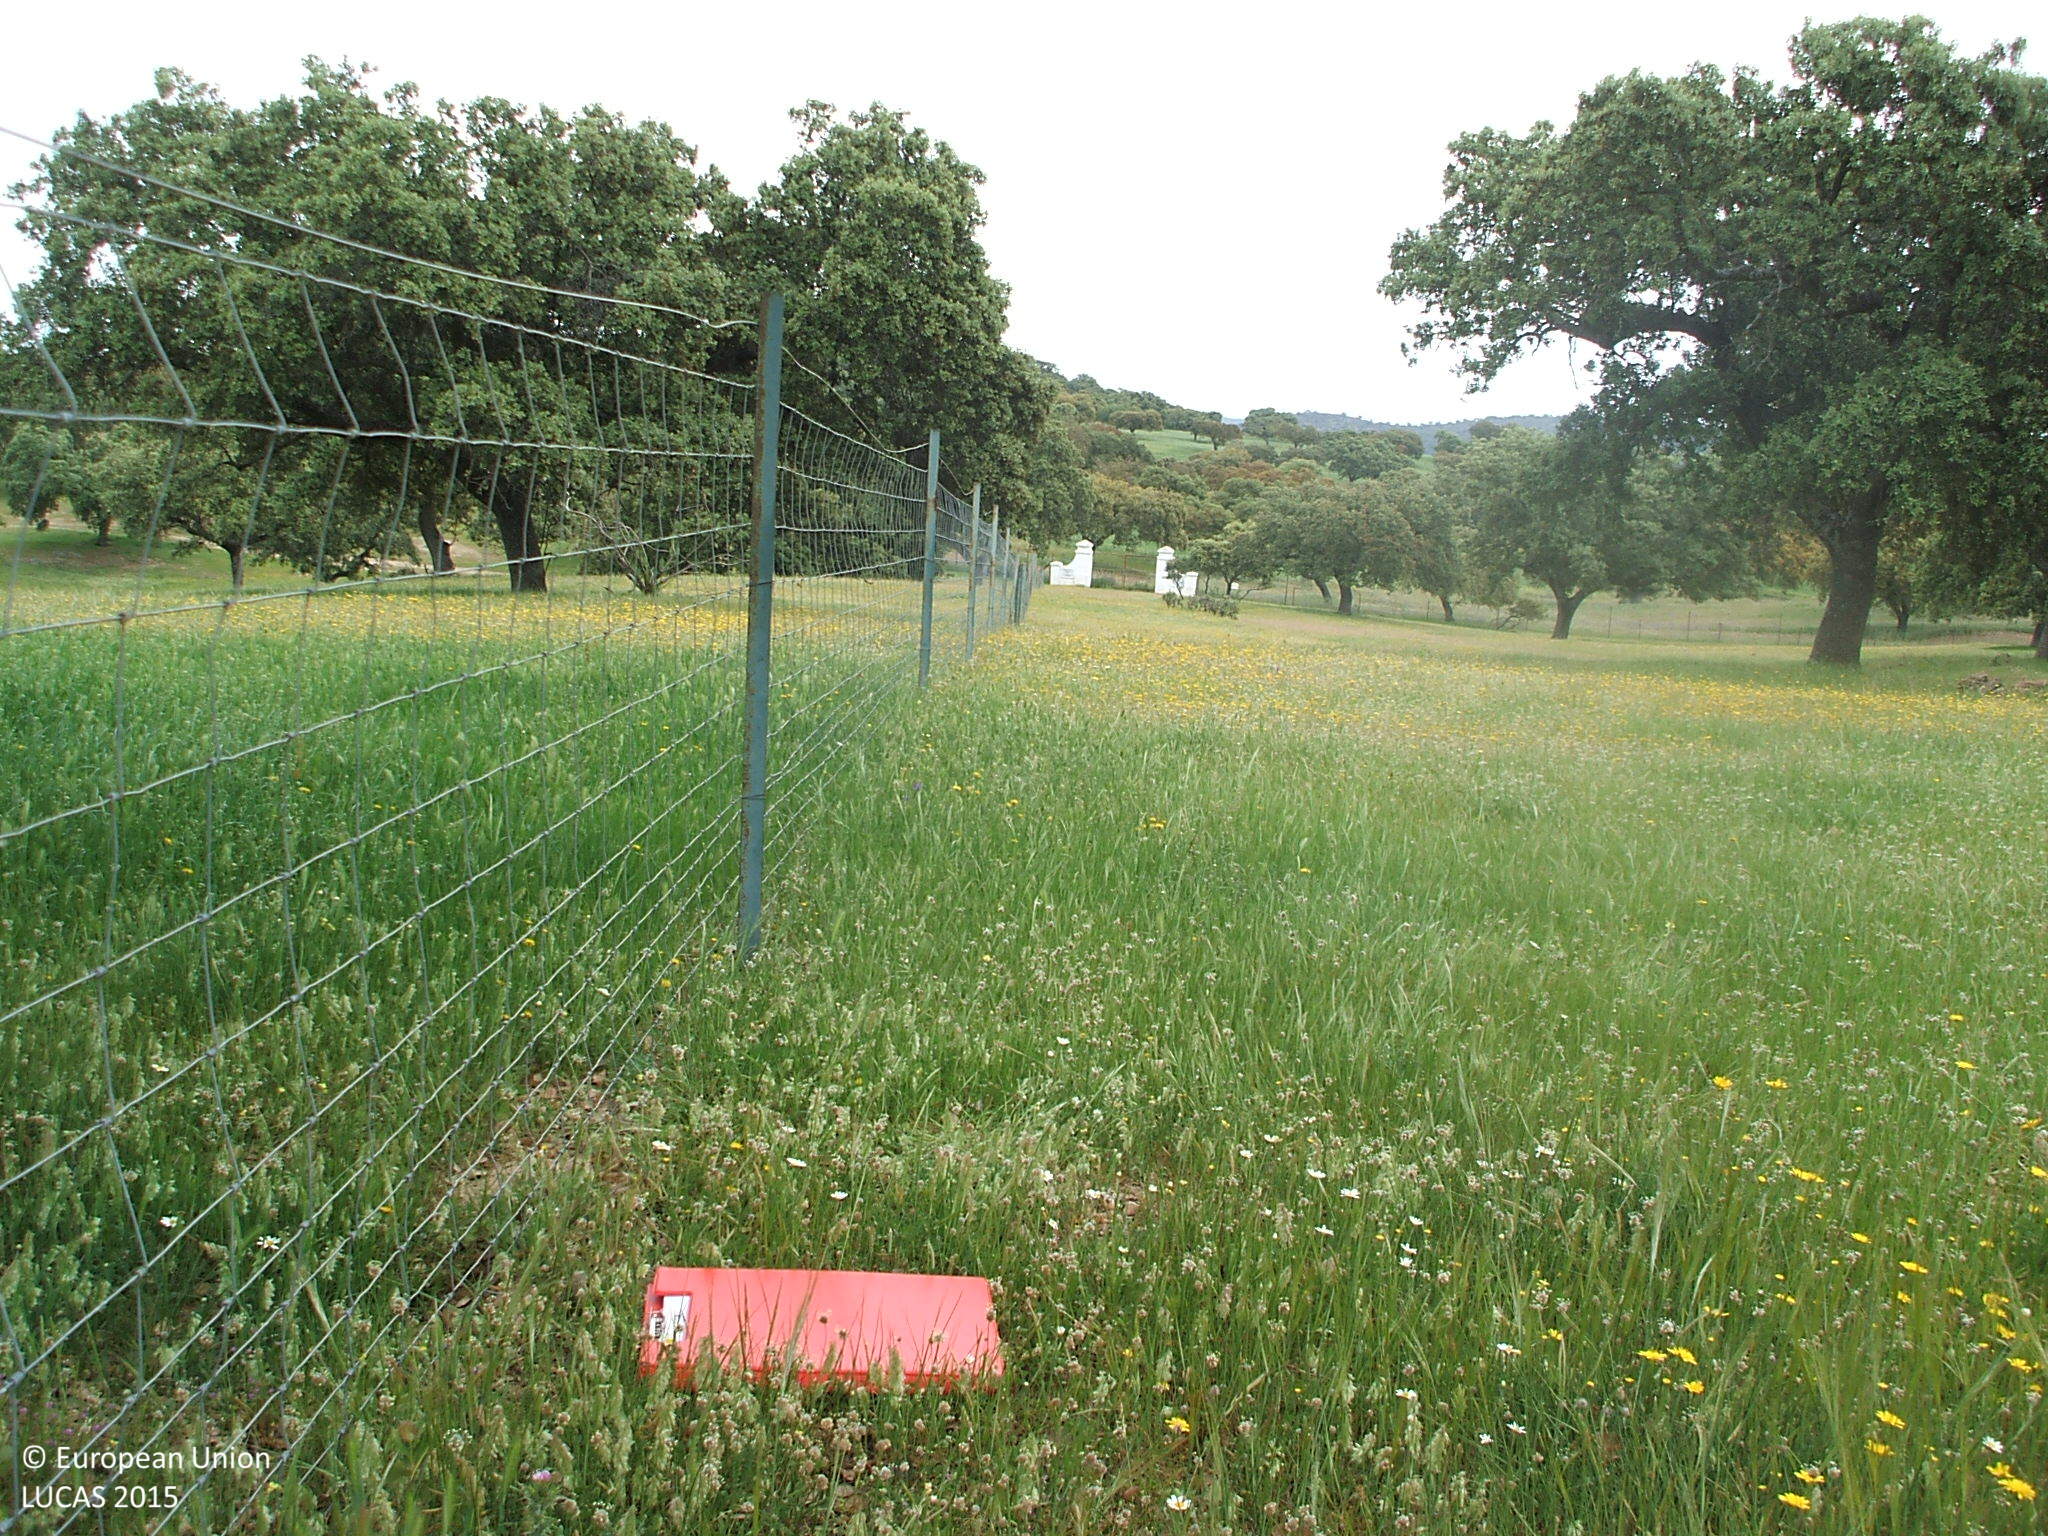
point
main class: Woodland
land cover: Broadleaved woodland
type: broadleaved evergreen forest
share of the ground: 10 - 25 %
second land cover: Grassland without tree/shrub cover
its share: > 75 %
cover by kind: herbaceous plants 80 %, broadleaved forest trees 20 %
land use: Forestry
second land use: Agriculture (excluding fallow land and kitchen gardens)
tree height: > 5 m
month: April
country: ES
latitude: 38.1722
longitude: -5.7753
